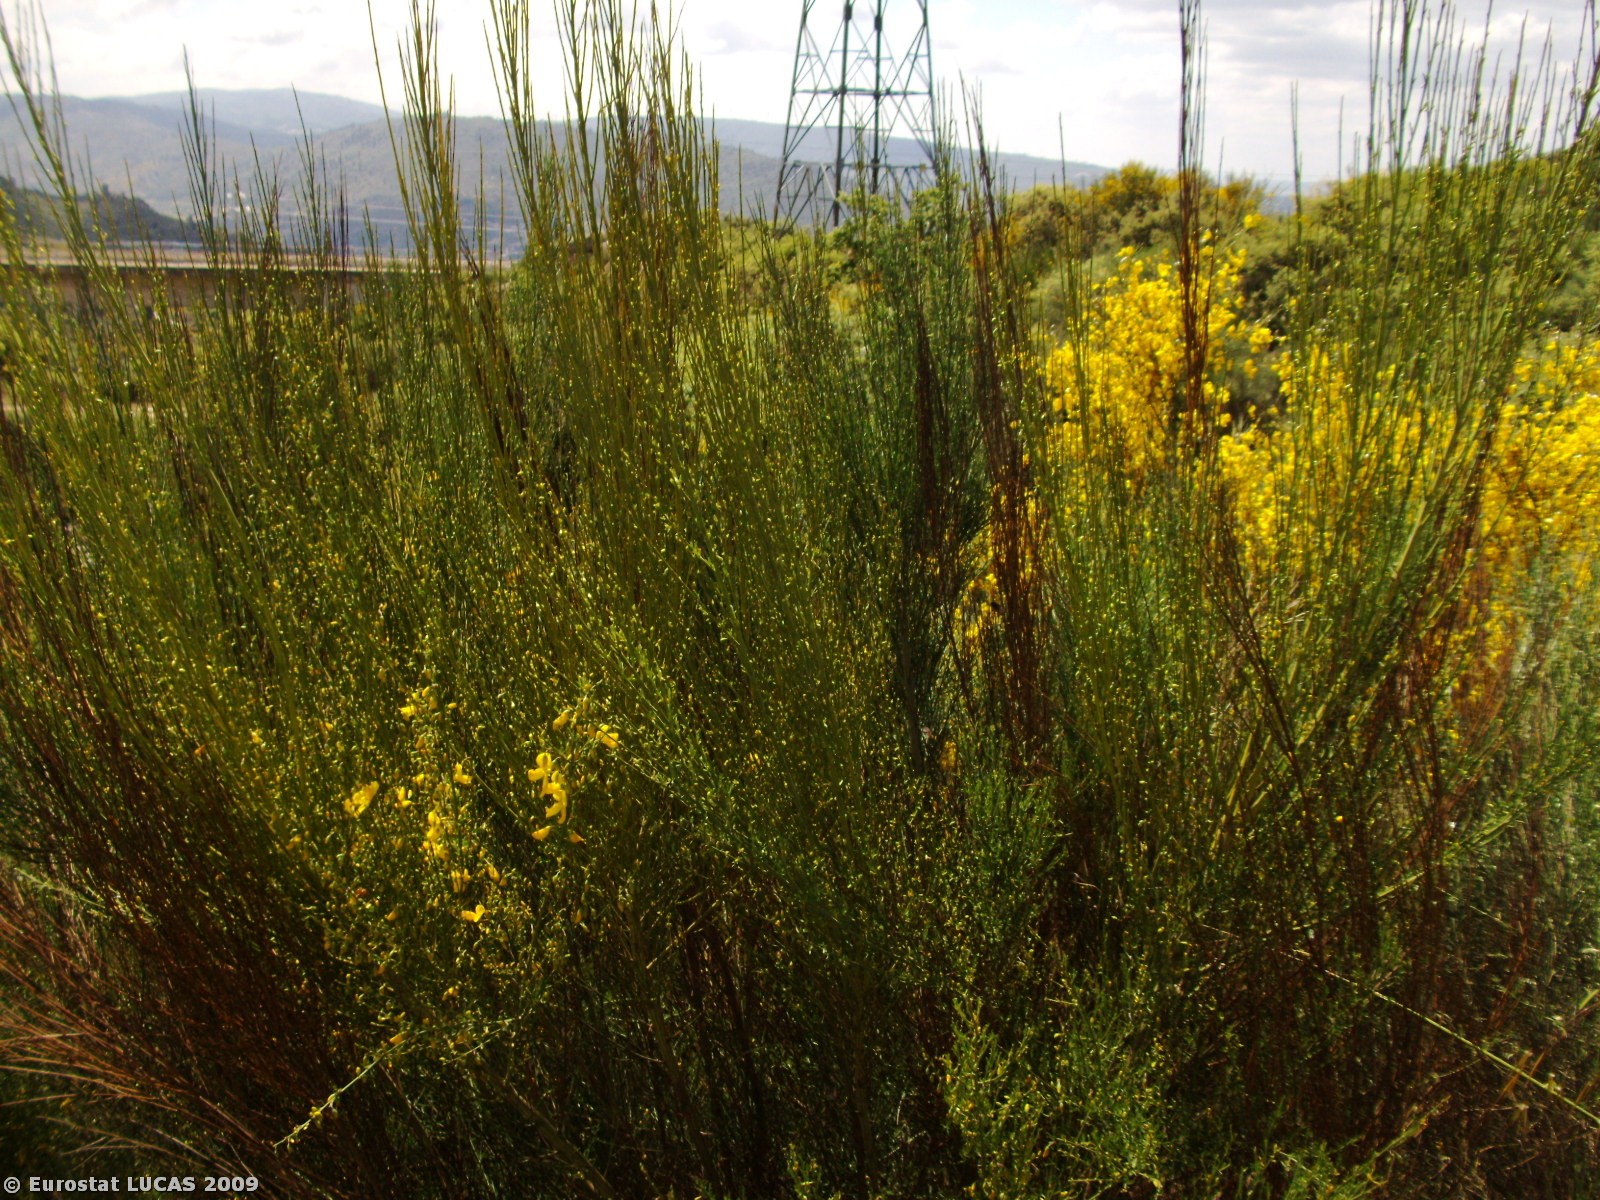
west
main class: Shrubland
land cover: Shrubland with sparse tree cover
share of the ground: > 75 %
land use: Unused
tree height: > 5 m
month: May
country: PT
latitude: 40.6244
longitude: -7.2603
